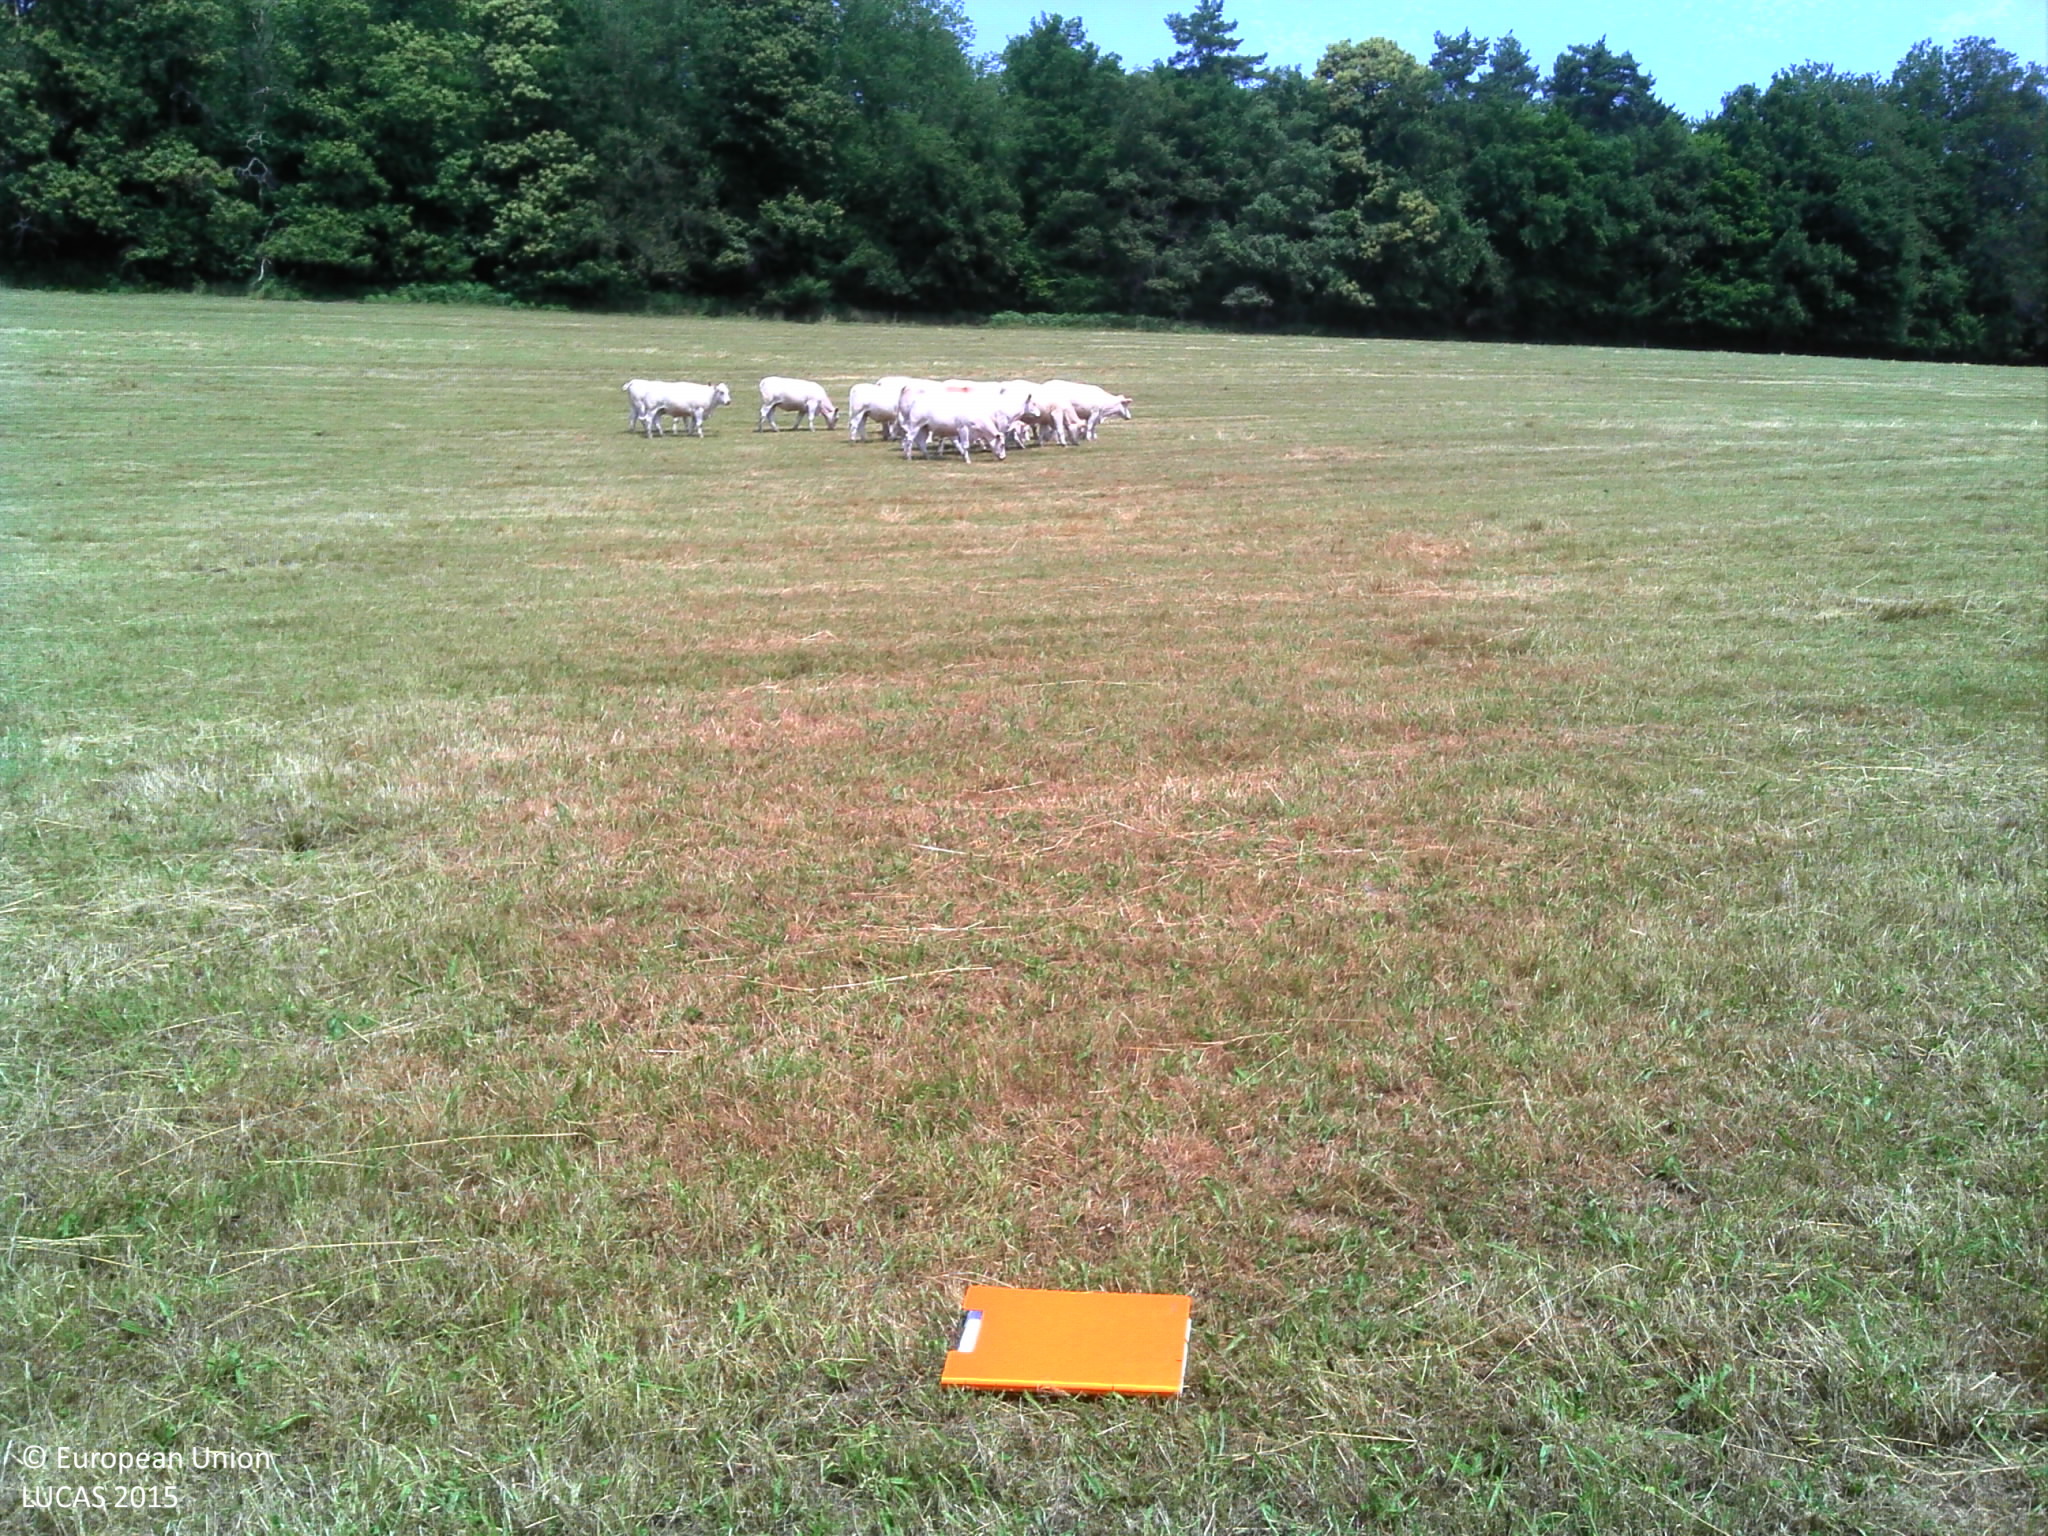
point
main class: Grassland
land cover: Grassland without tree/shrub cover
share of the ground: > 75 %
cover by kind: herbaceous plants 100 %
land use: Agriculture (excluding fallow land and kitchen gardens)
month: June
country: FR
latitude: 46.9559
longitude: 3.9412
